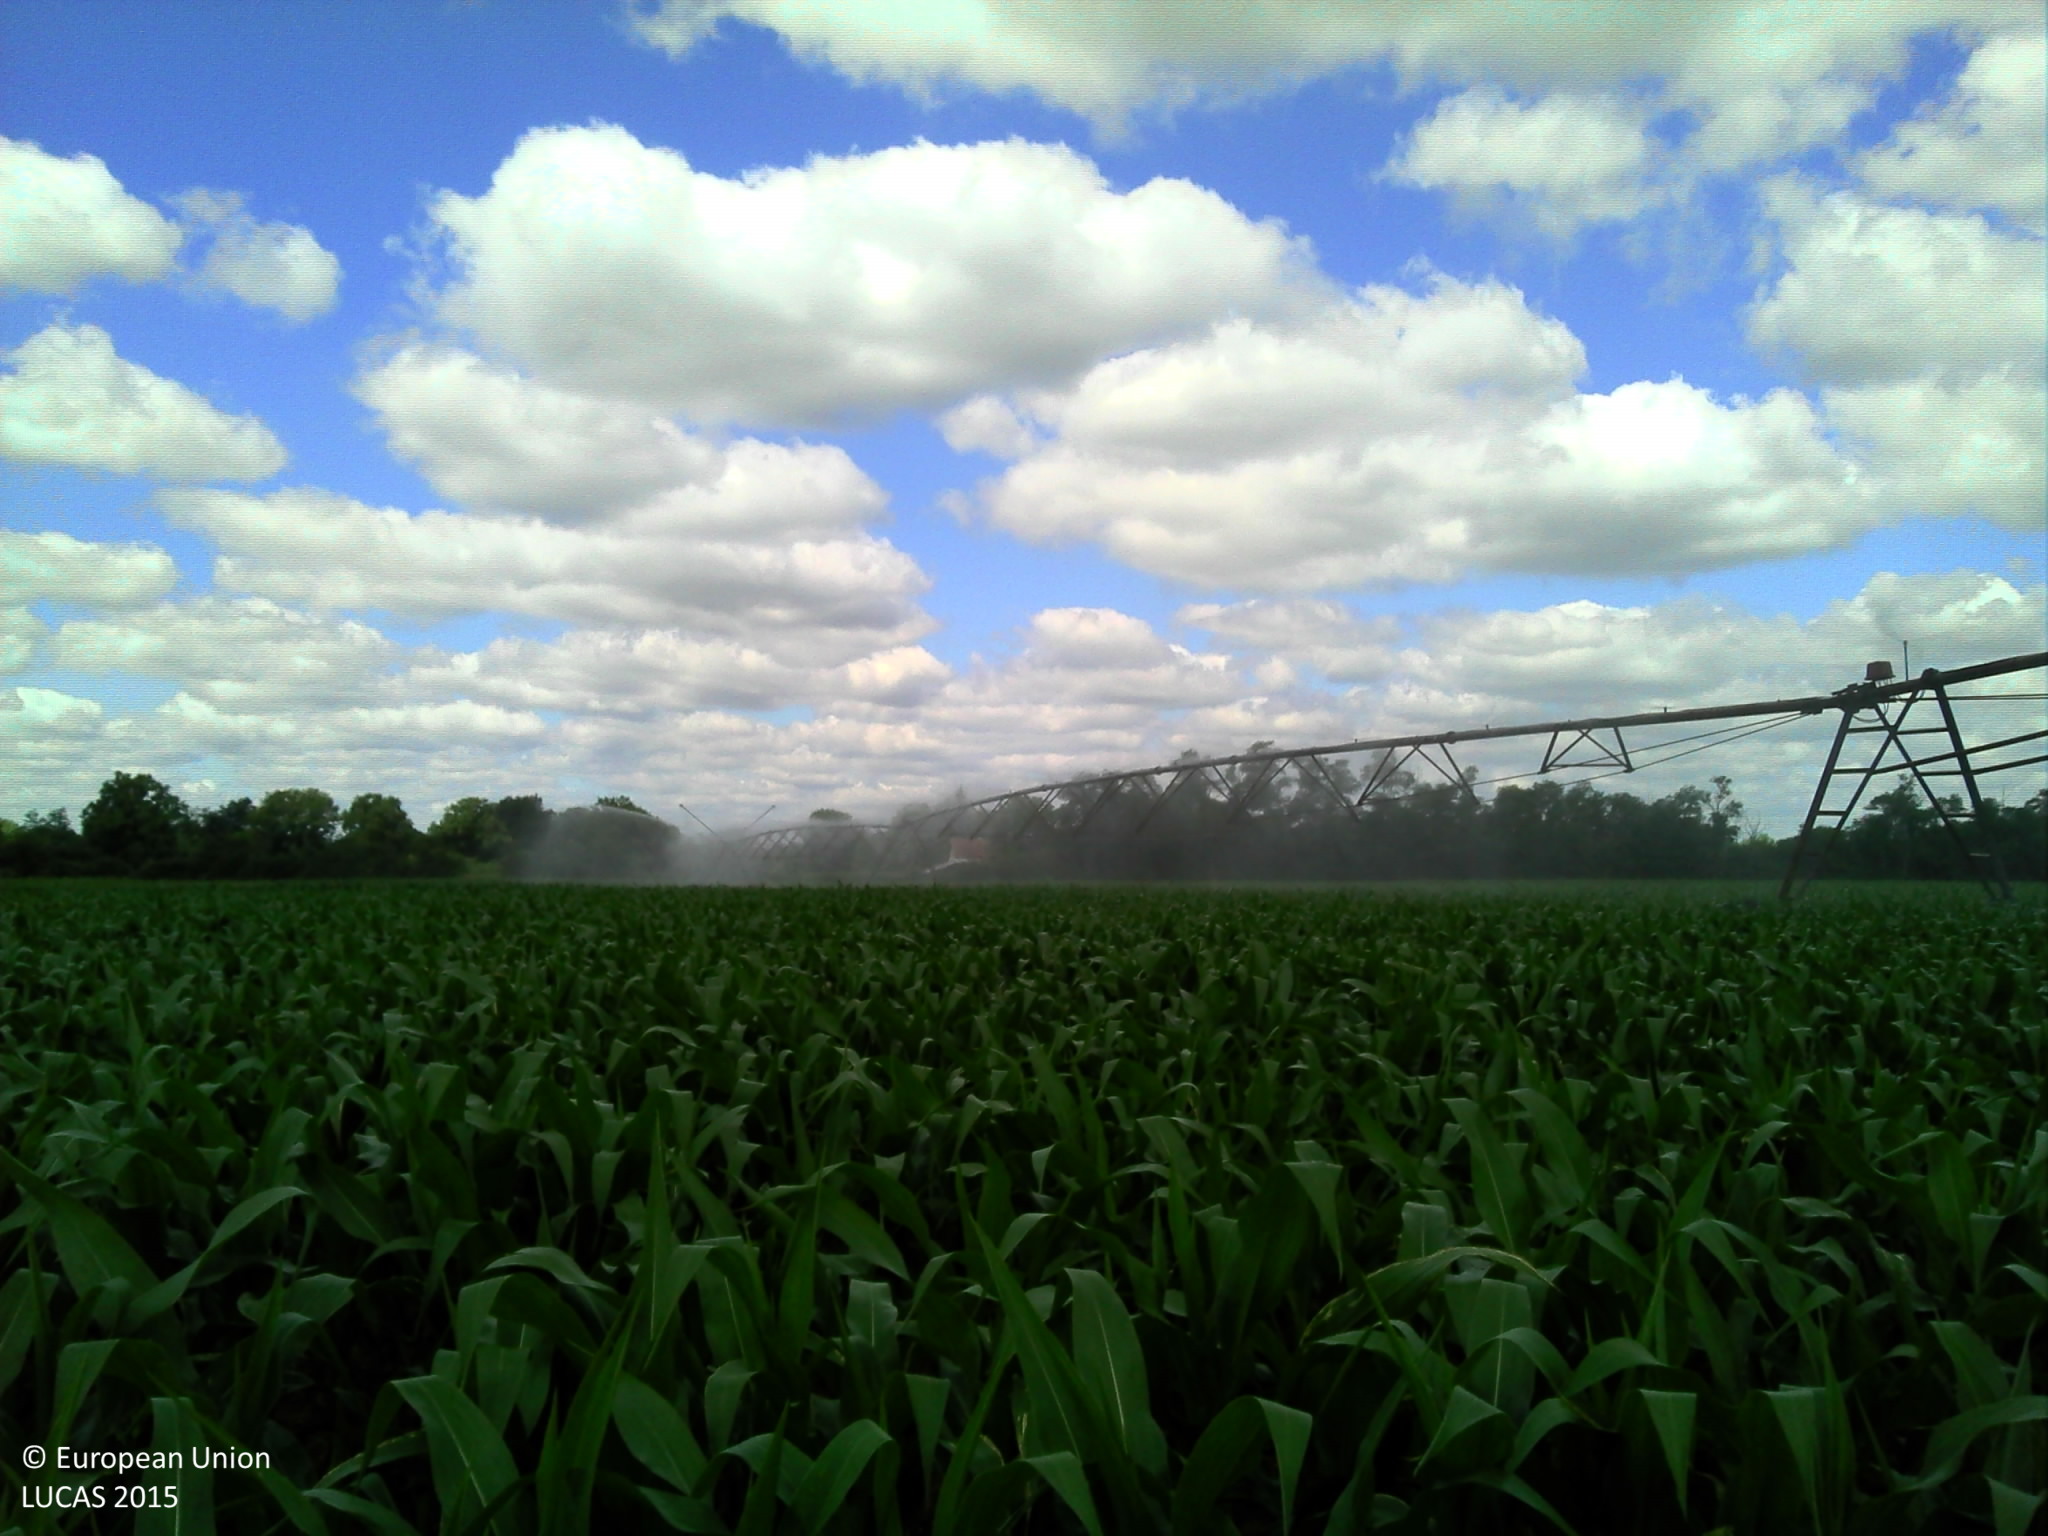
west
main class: Cropland
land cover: Maize
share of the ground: > 75 %
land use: Agriculture (excluding fallow land and kitchen gardens)
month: June
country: FR
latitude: 46.7032
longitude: 3.6292
